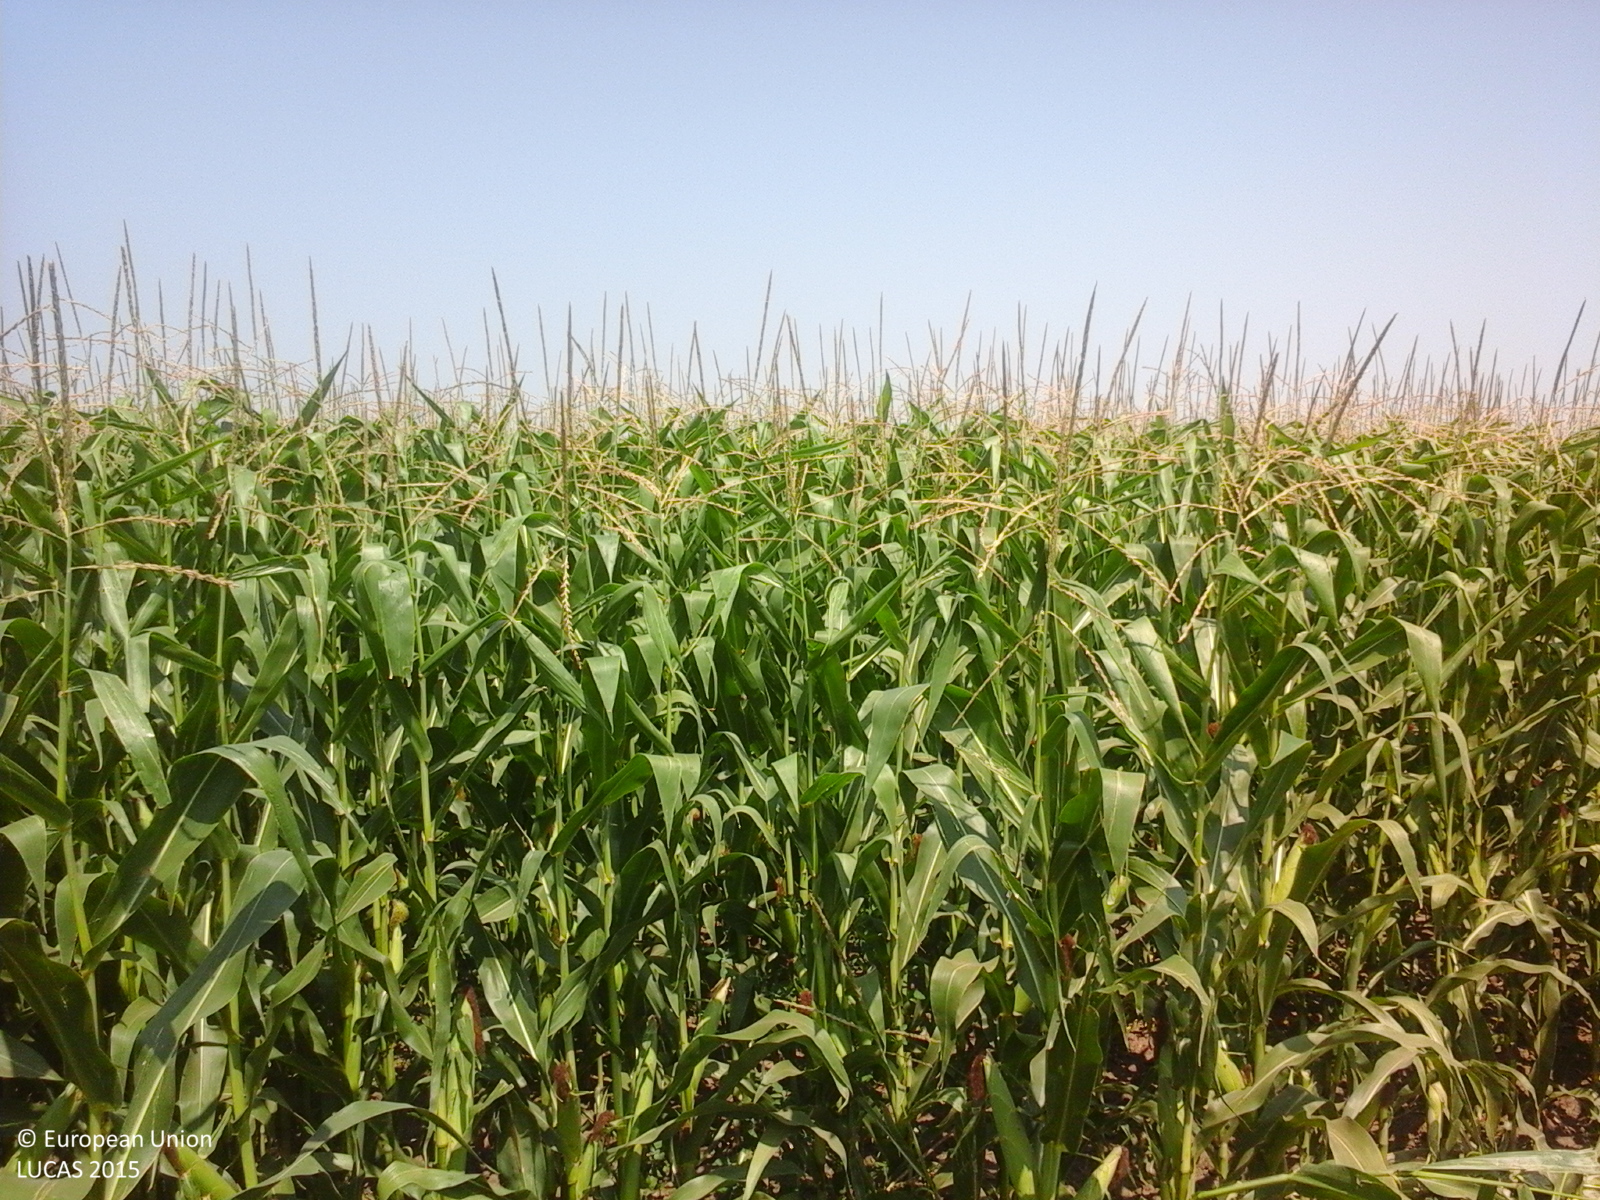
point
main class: Cropland
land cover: Maize
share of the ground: > 75 %
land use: Agriculture (excluding fallow land and kitchen gardens)
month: July
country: RO
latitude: 44.7235
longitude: 27.0895
